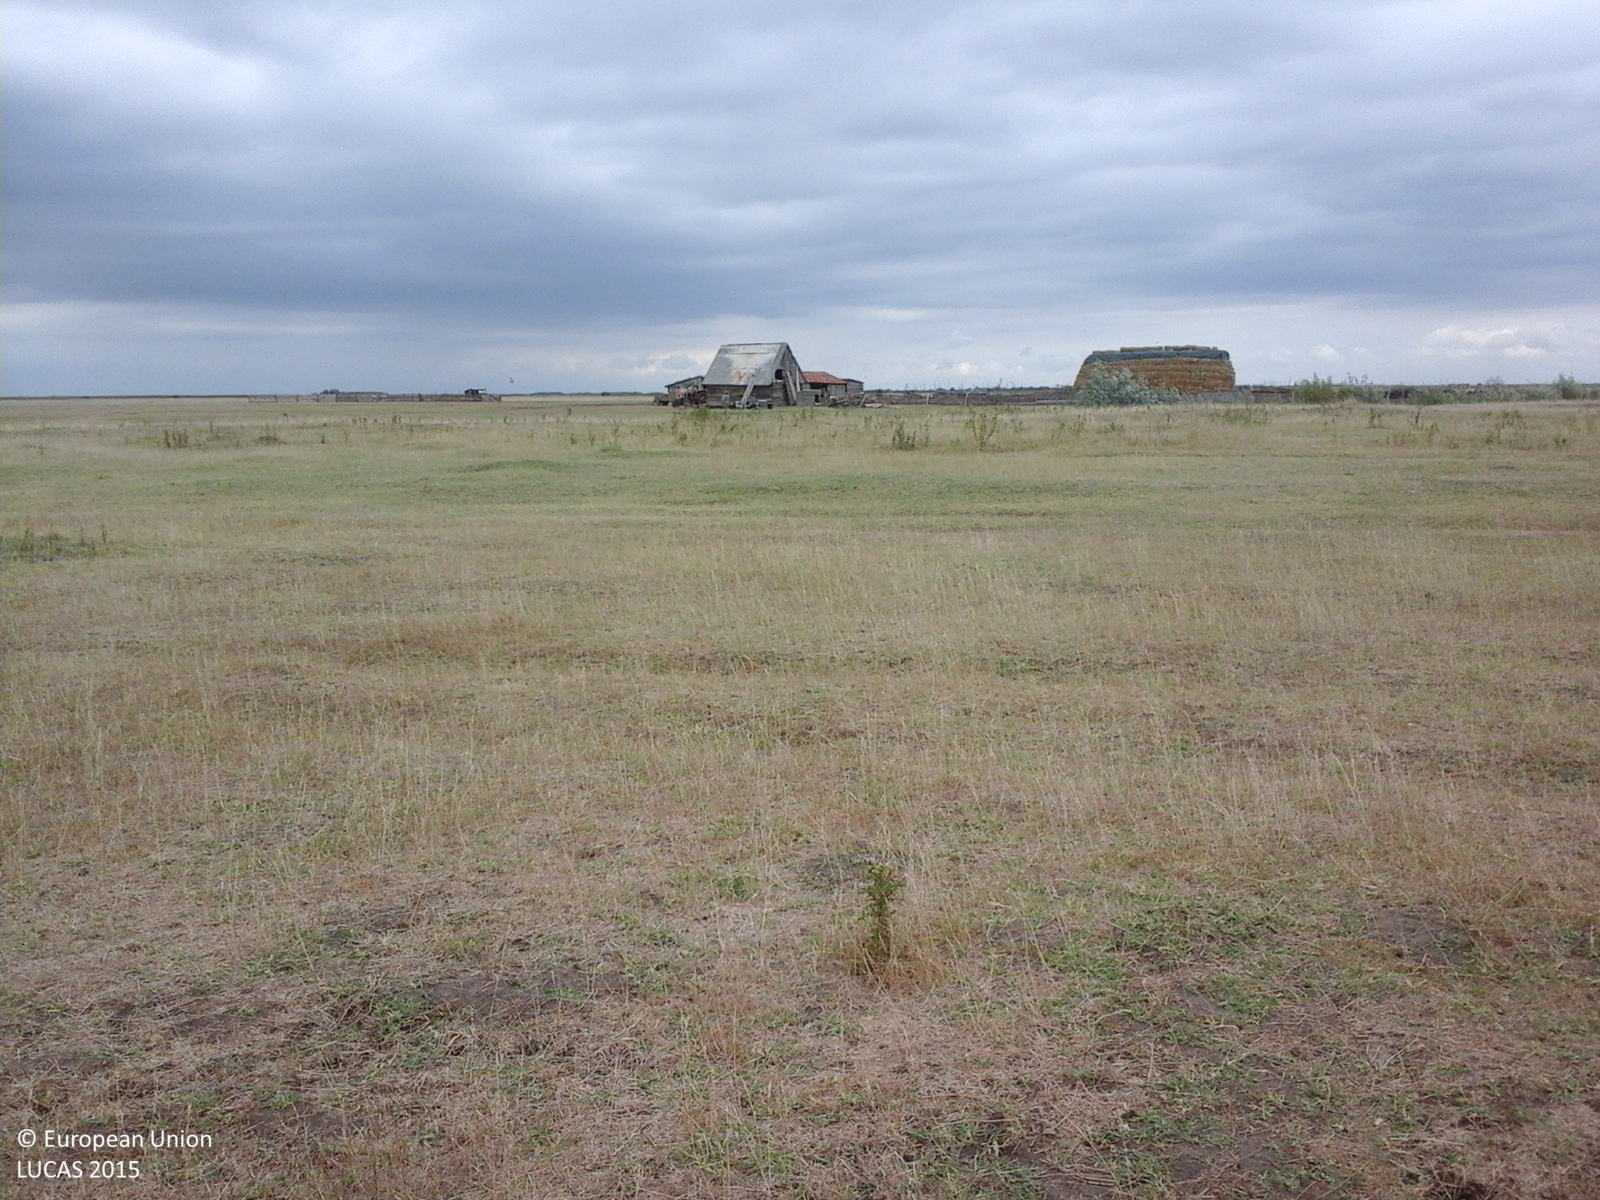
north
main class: Grassland
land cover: Grassland without tree/shrub cover
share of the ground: > 75 %
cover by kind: herbaceous plants 100 %
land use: Agriculture (excluding fallow land and kitchen gardens)
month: August
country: RO
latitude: 45.5125
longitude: 20.9708
